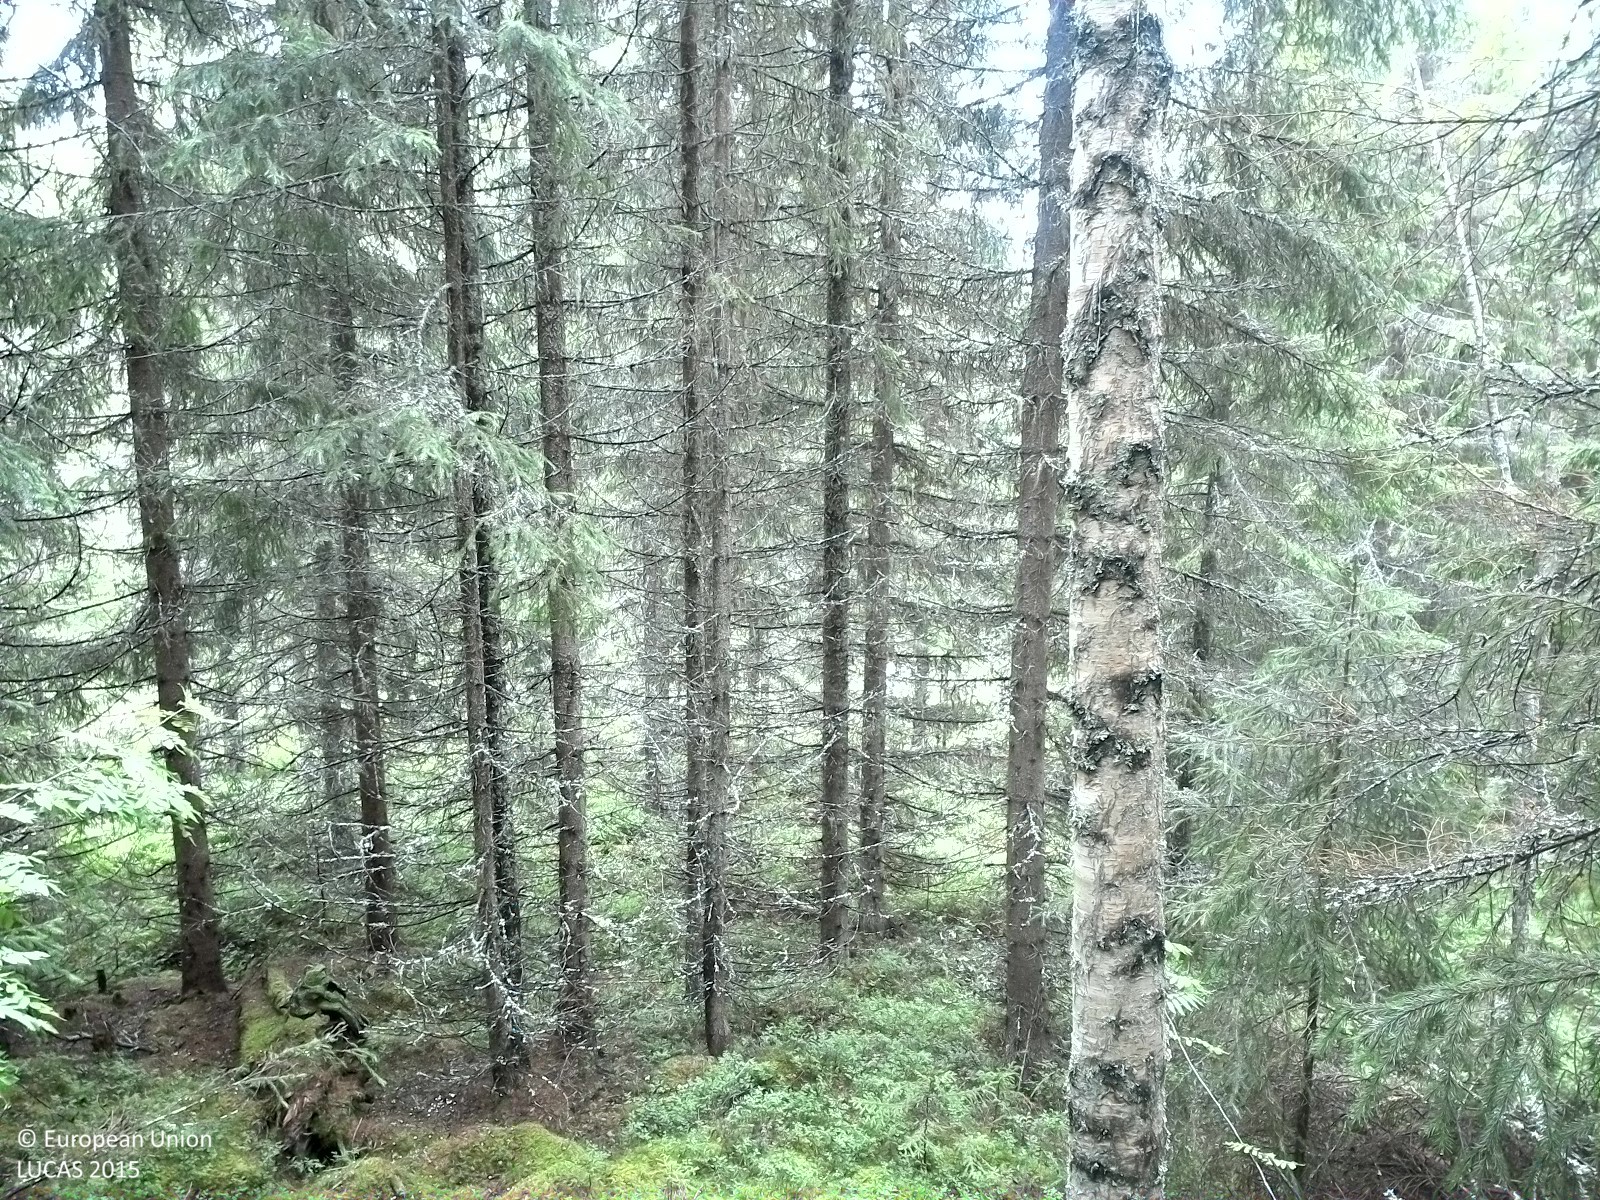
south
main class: Woodland
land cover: Spruce dominated coniferous woodland
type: boreal forest
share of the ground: 50 - 75 %
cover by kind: coniferous forest trees 60 %, shrubs 15 %, lichens and mosses 15 %, broadleaved forest trees 10 %
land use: Forestry
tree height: > 5 m
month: August
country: SE
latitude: 62.6566
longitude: 16.8282
